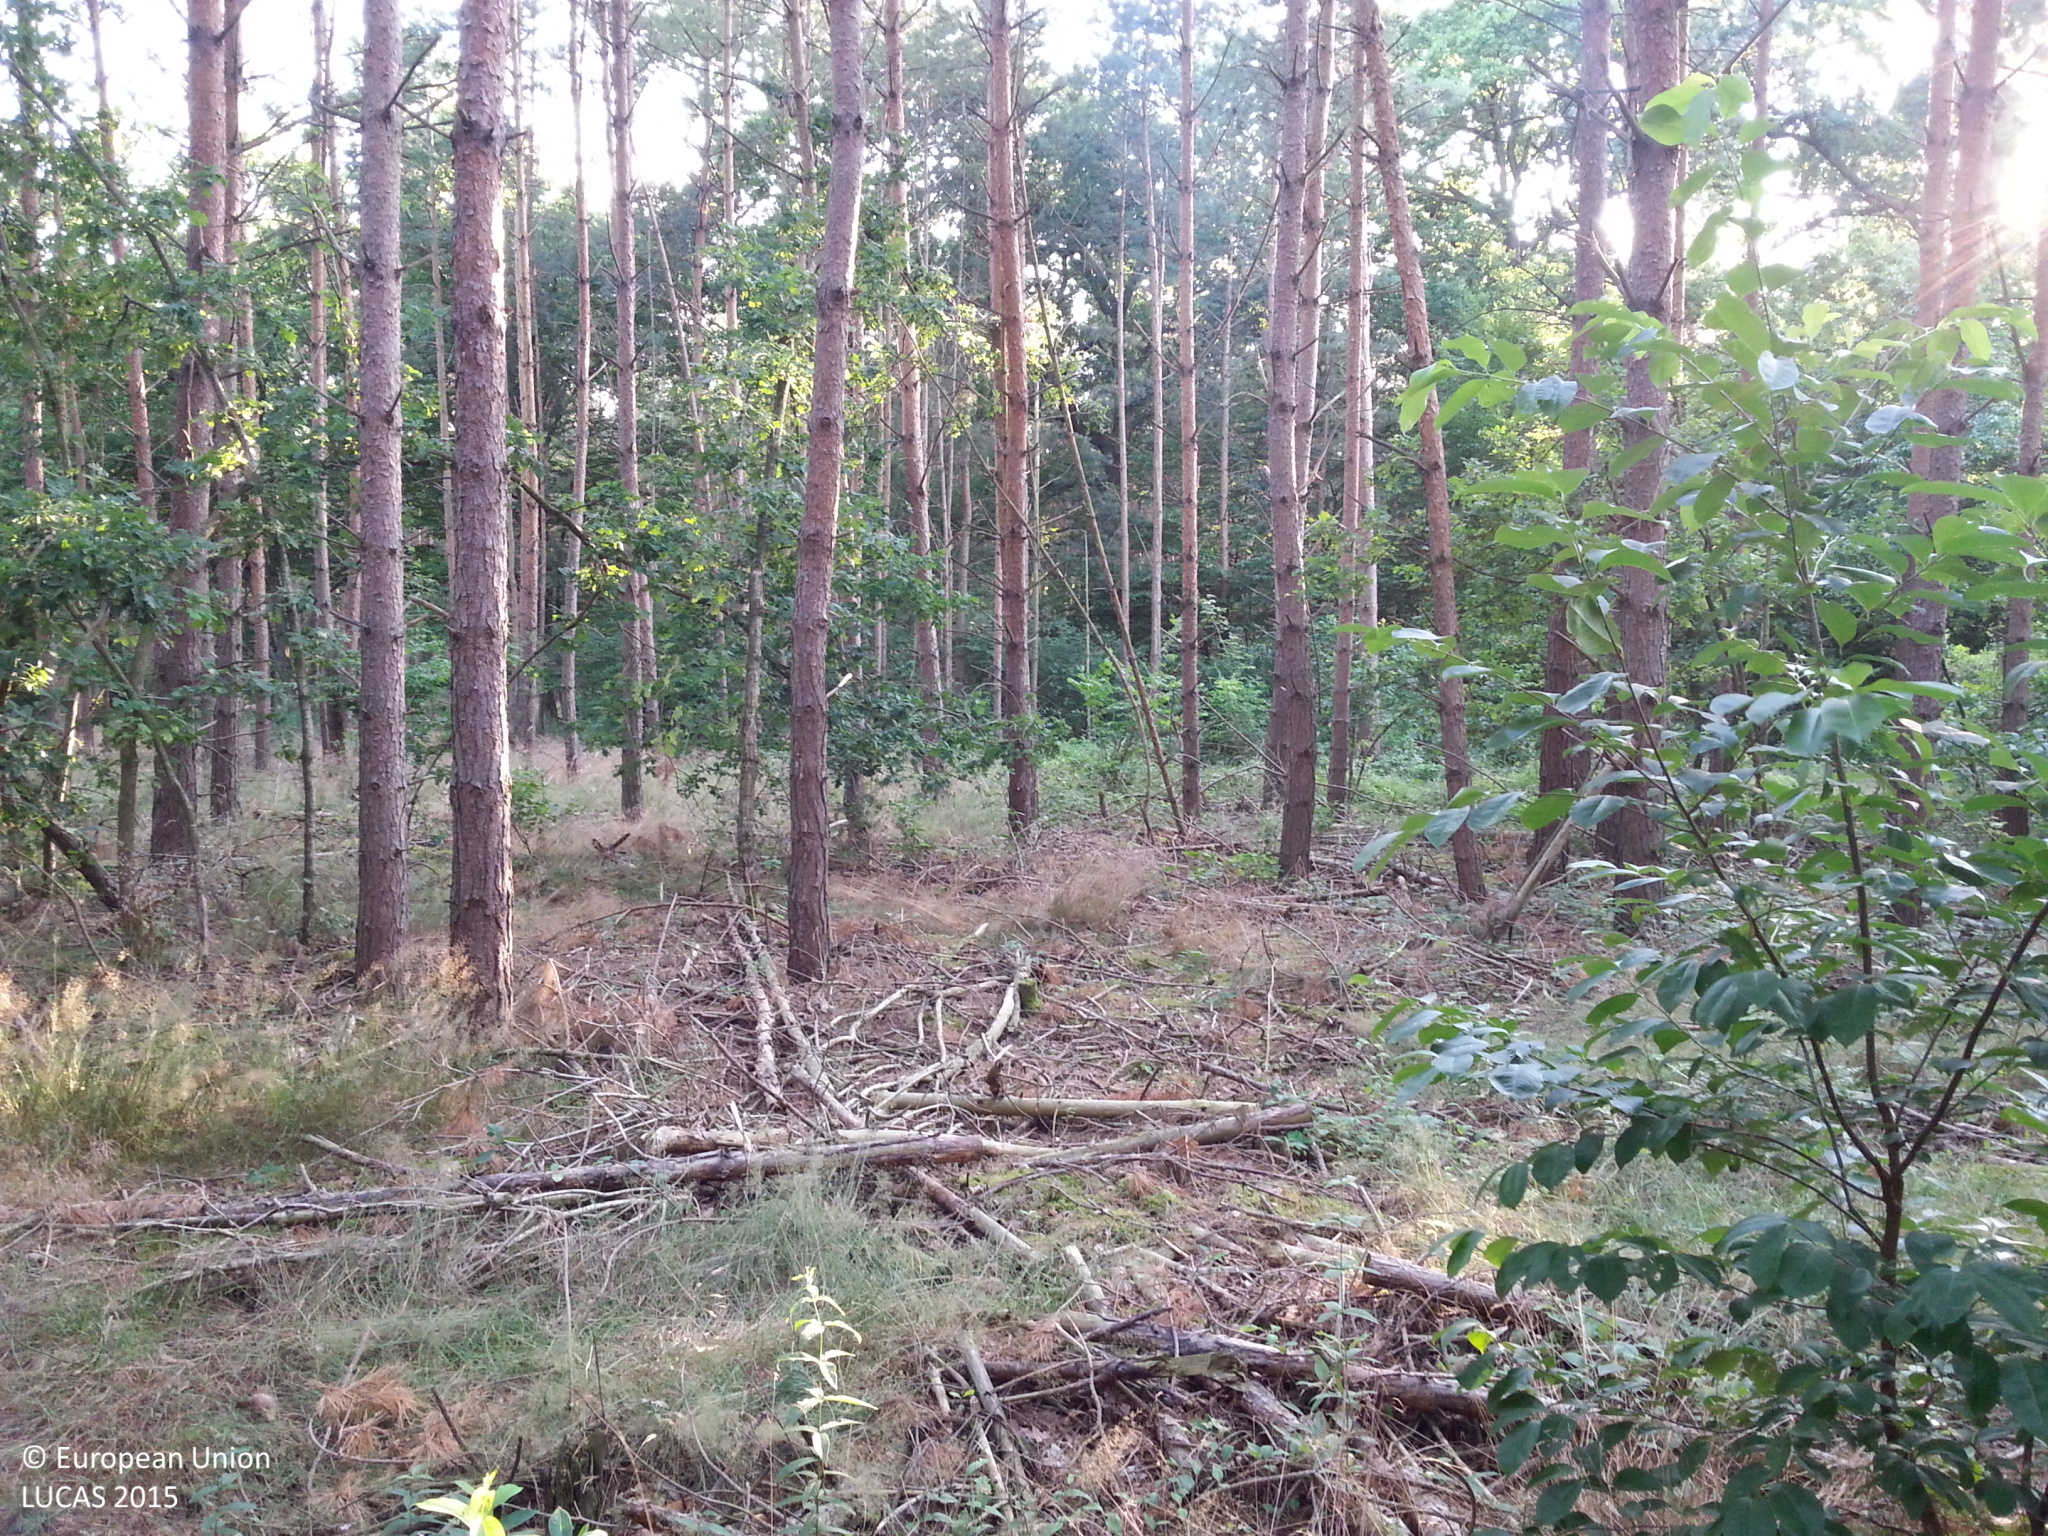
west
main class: Woodland
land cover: Pine dominated coniferous woodland
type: hemiboreal forest and nemoral coniferous forest and mixed broadleaved-coniferous forest
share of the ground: 50 - 75 %
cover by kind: coniferous forest trees 55 %, lichens and mosses 15 %, unconsolidated bare surface 15 %, herbaceous plants 10 %, shrubs 5 %
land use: Forestry
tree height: > 5 m
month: July
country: DE
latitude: 53.0298
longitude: 11.7440
